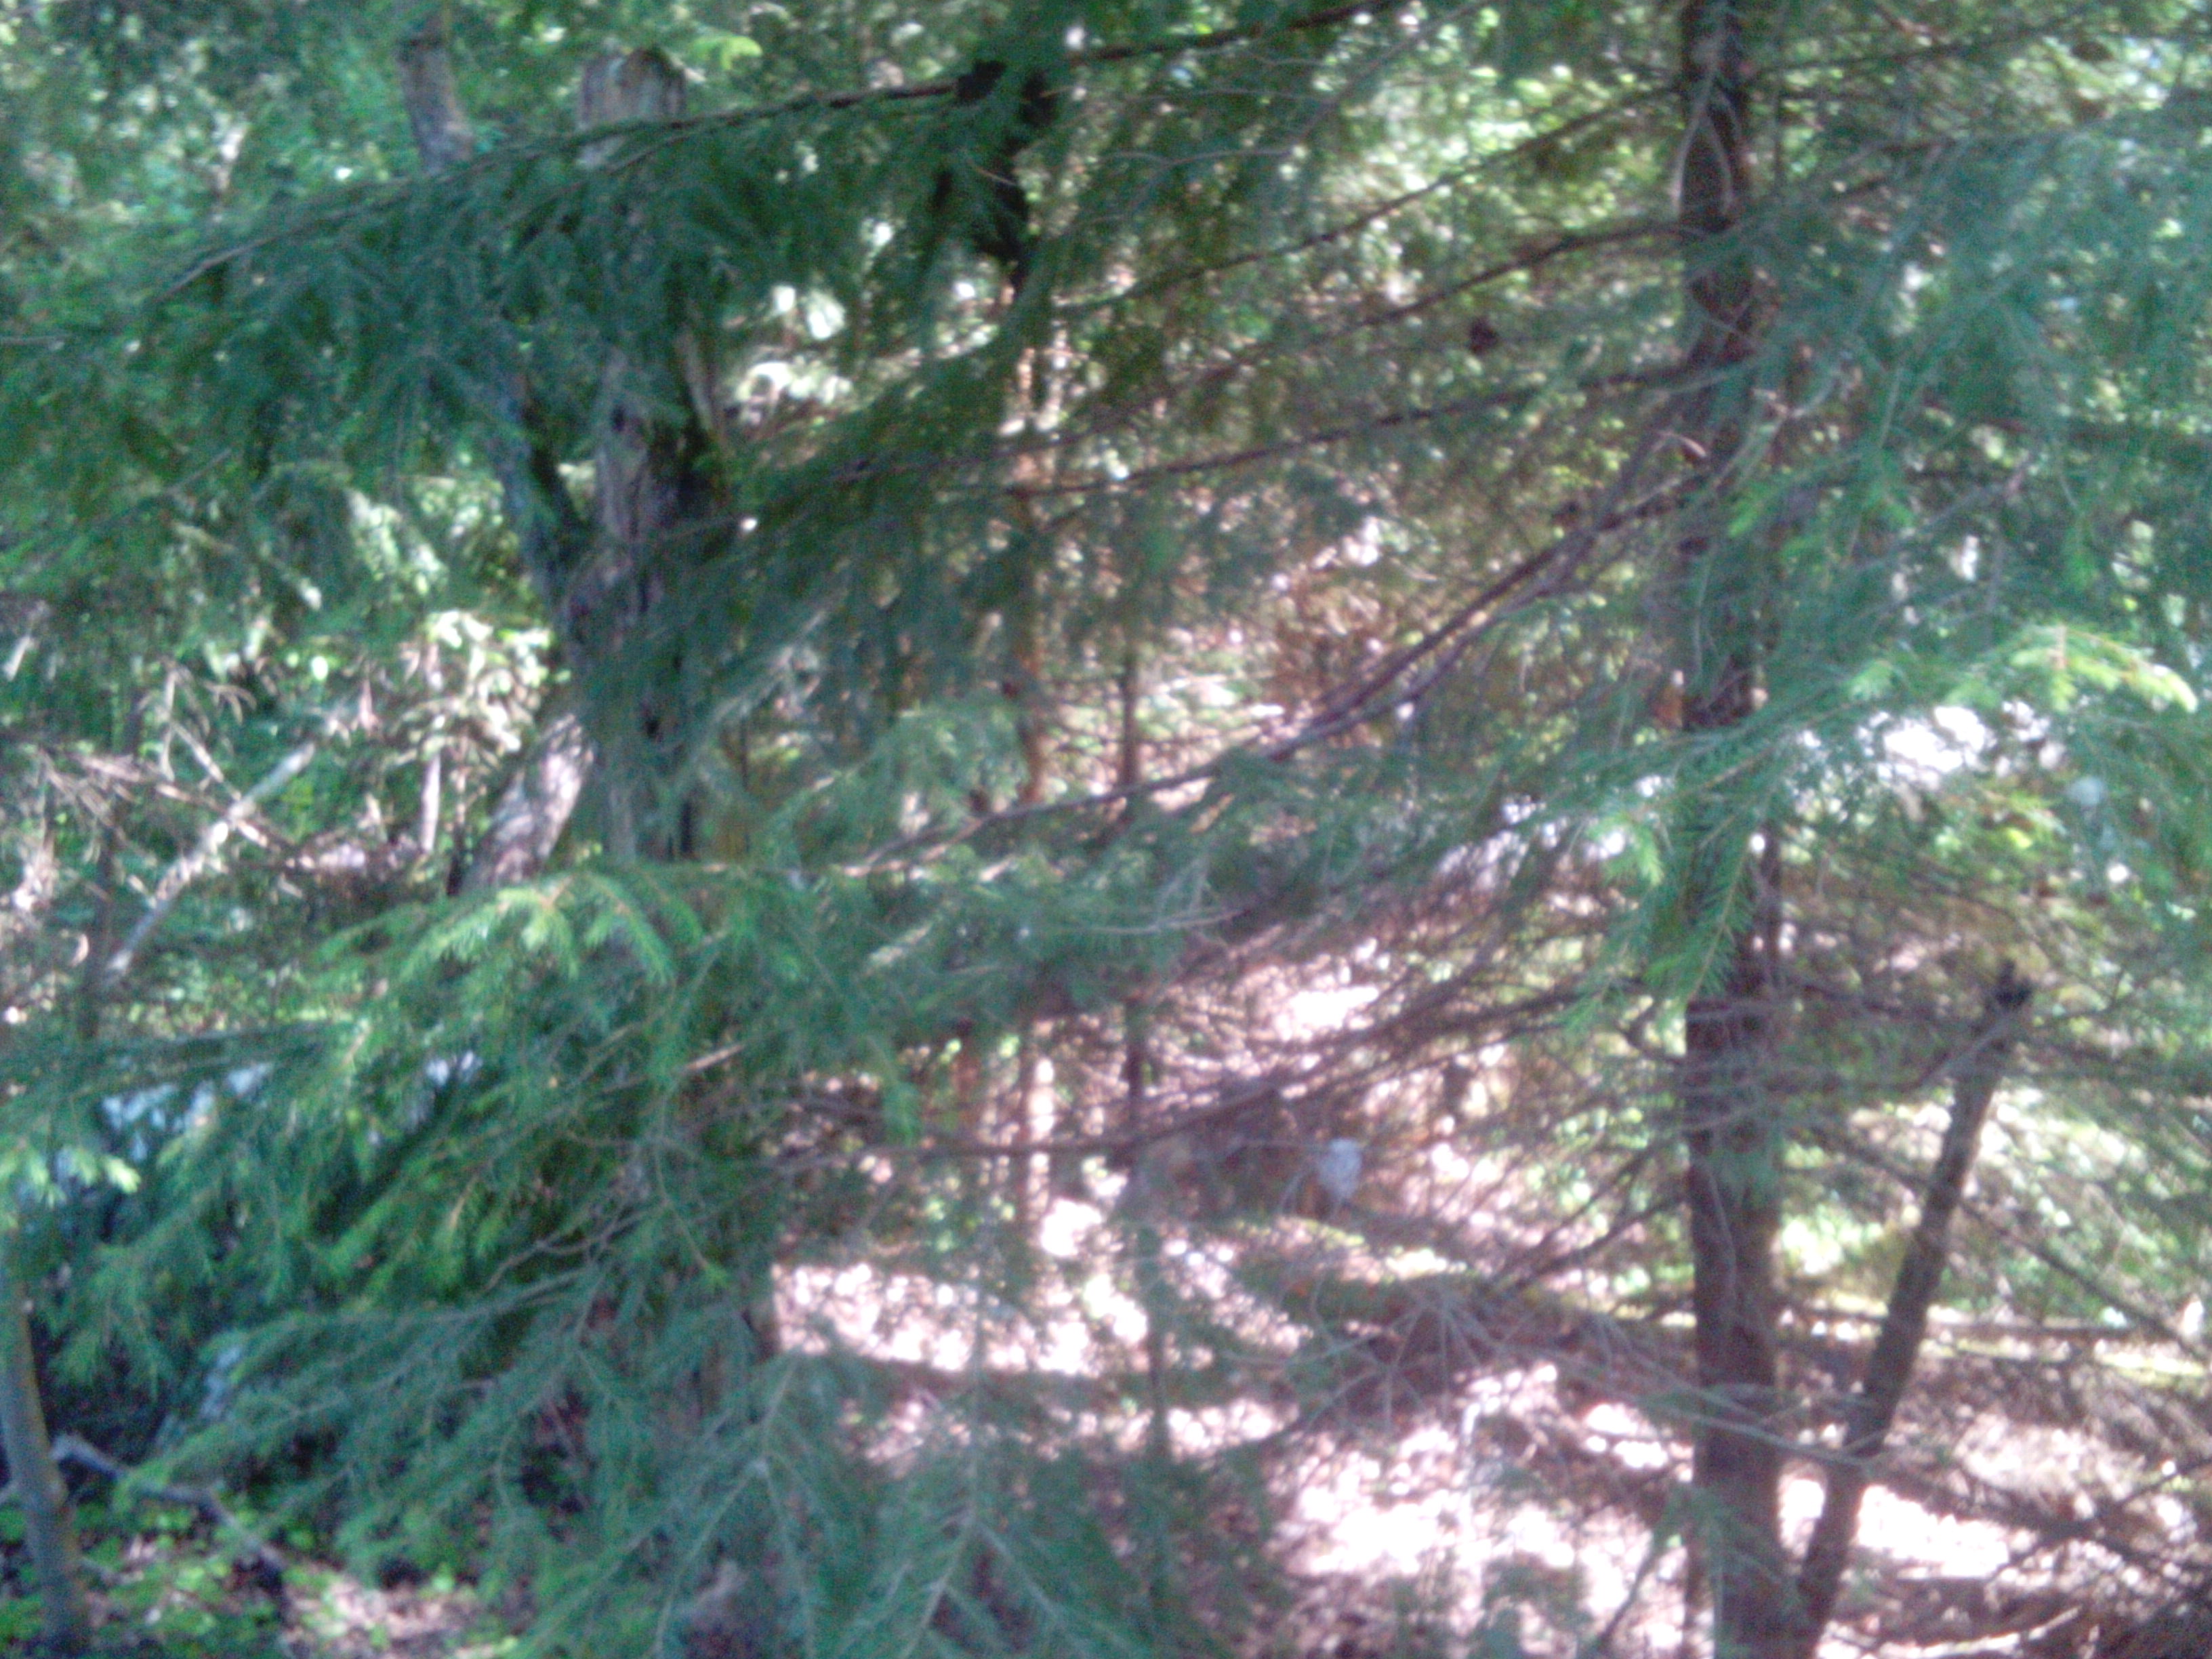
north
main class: Woodland
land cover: Spruce dominated mixed woodland
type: hemiboreal forest and nemoral coniferous forest and mixed broadleaved-coniferous forest
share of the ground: > 75 %
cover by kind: broadleaved forest trees 55 %, coniferous forest trees 40 %, shrubs 5 %
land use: Forestry
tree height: > 5 m
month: June
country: LV
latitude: 56.6710
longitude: 21.8781
